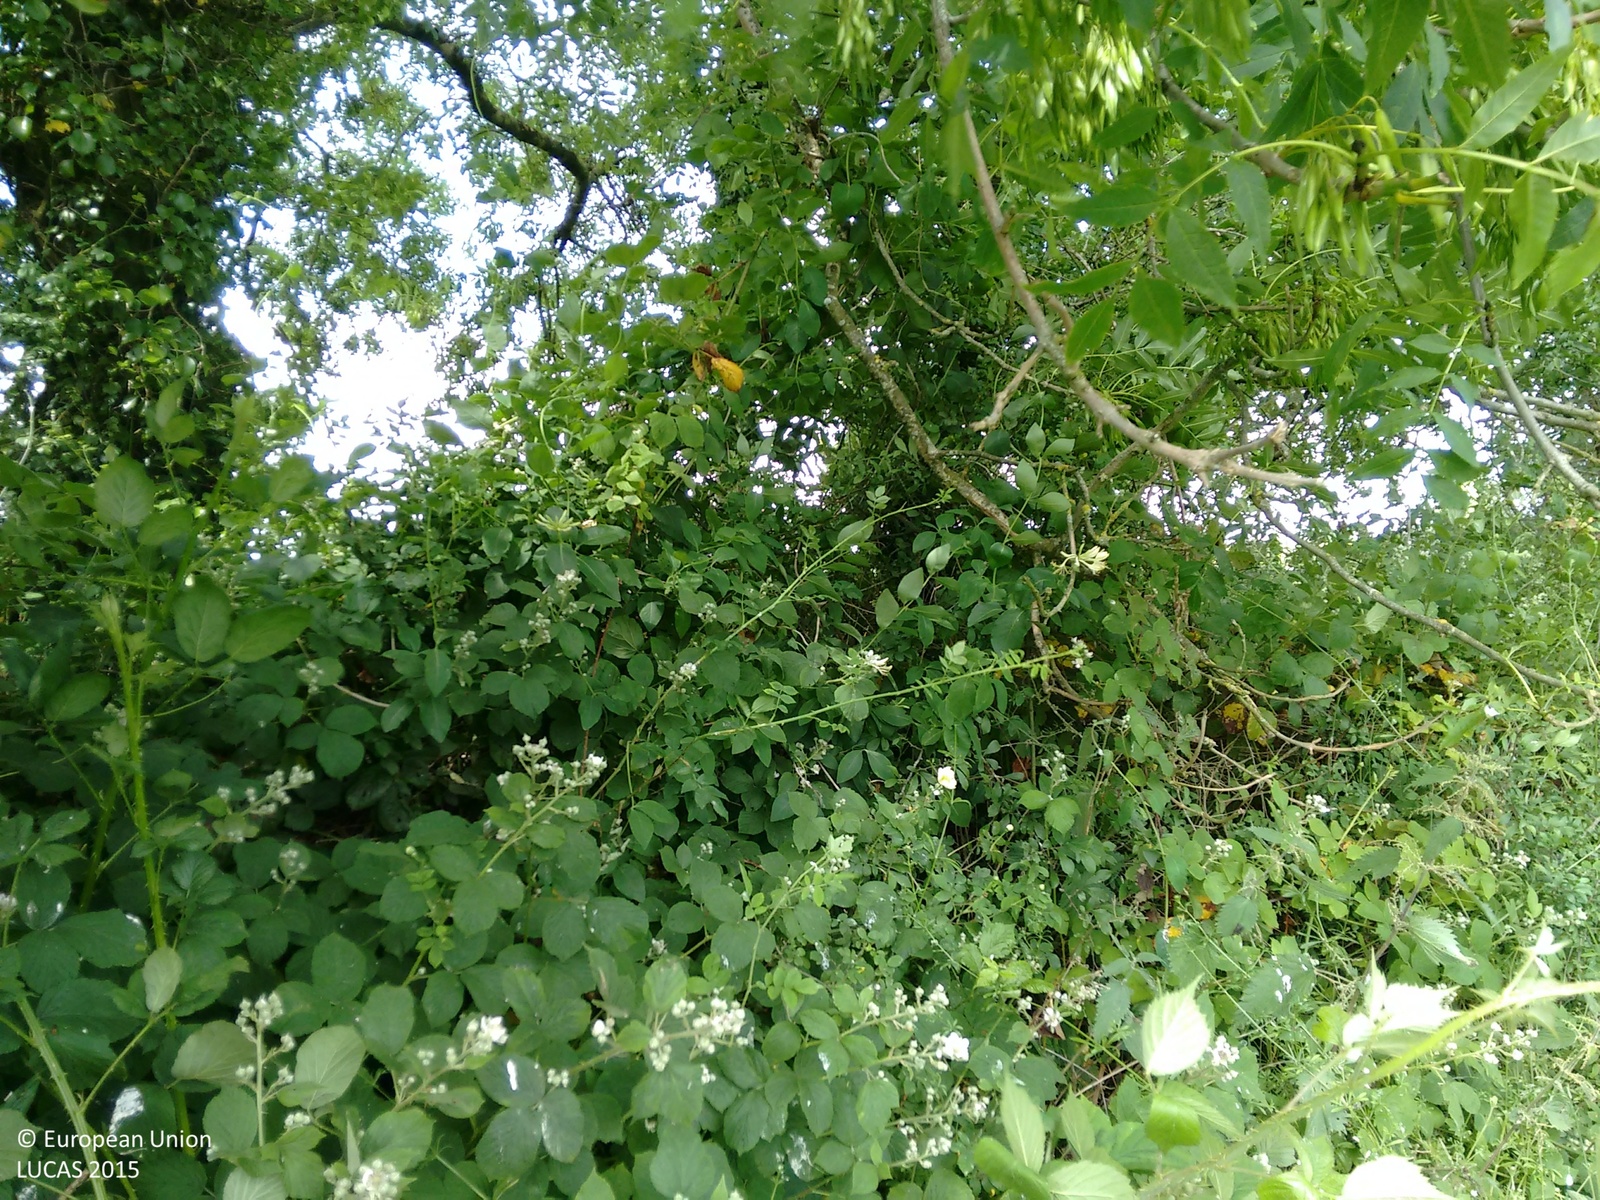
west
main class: Grassland
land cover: Grassland without tree/shrub cover
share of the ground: > 75 %
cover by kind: herbaceous plants 100 %
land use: Agriculture (excluding fallow land and kitchen gardens)
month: July
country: IE
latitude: 52.5348
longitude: -7.6332
